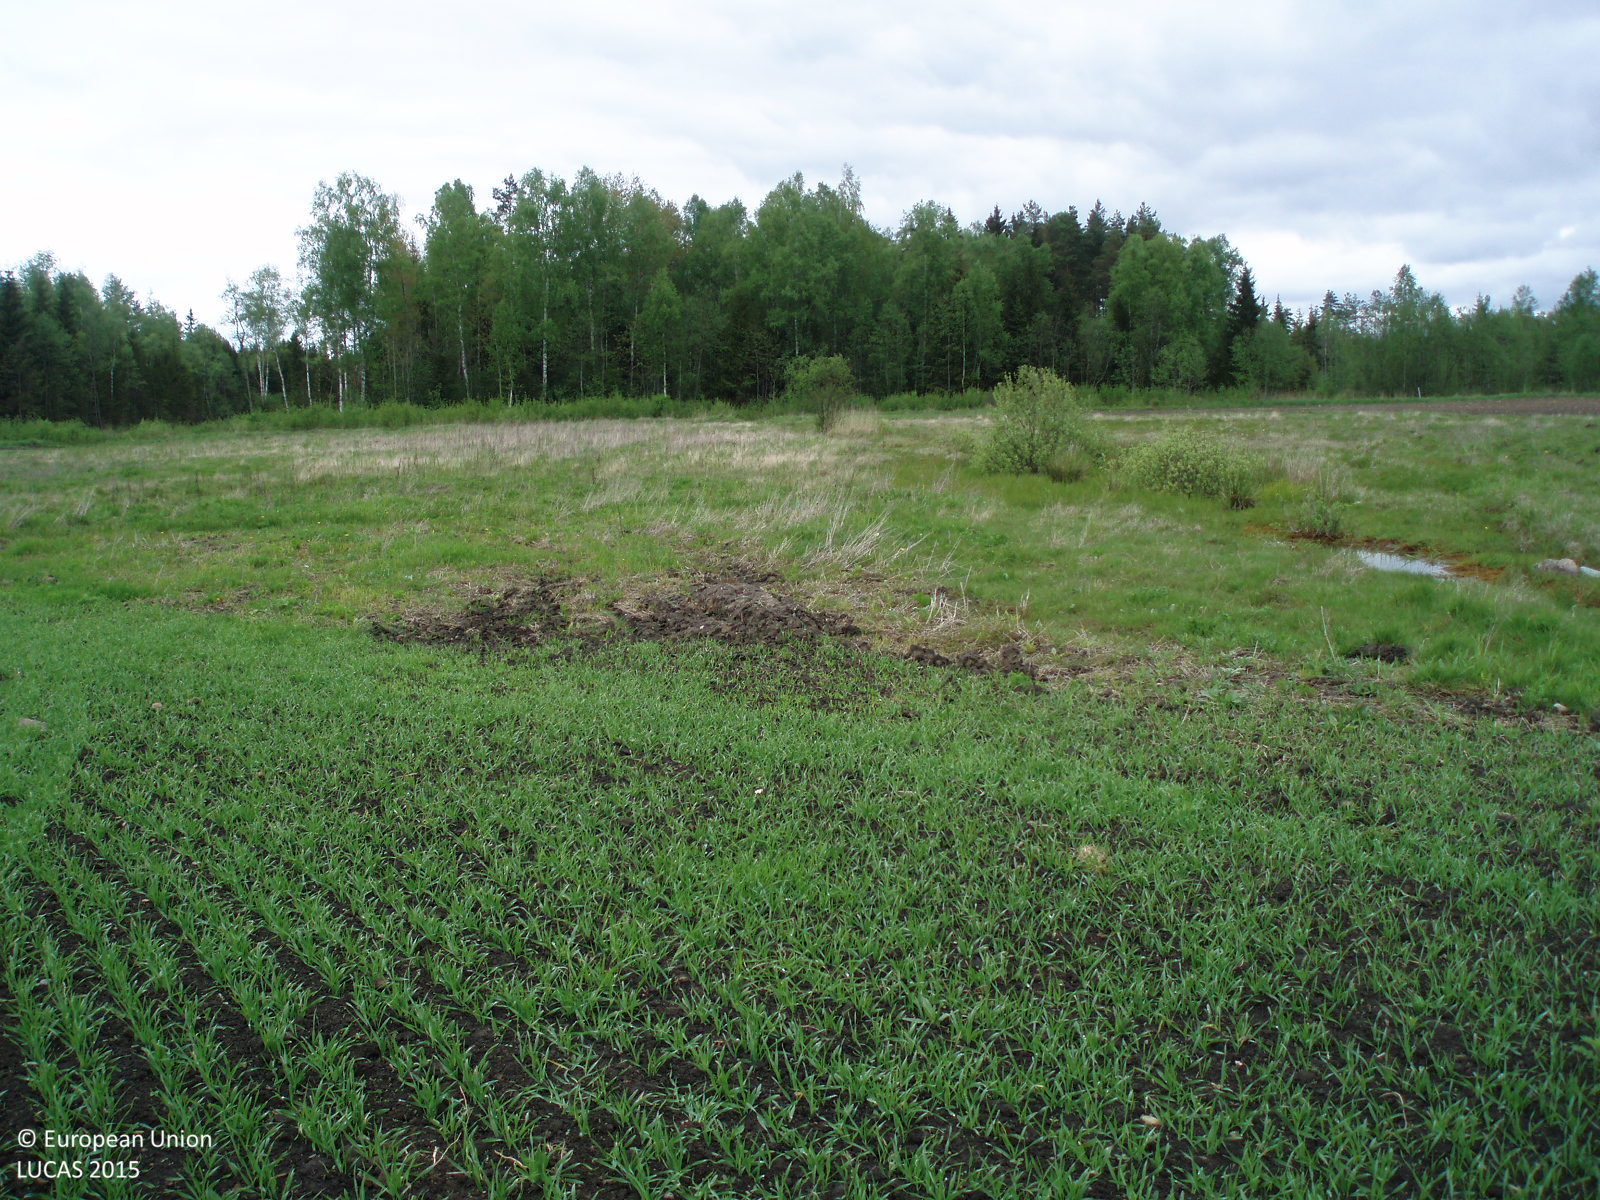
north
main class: Cropland
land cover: Barley
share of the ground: 50 - 75 %
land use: Agriculture (excluding fallow land and kitchen gardens)
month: May
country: LT
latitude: 56.3327
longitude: 22.5616
